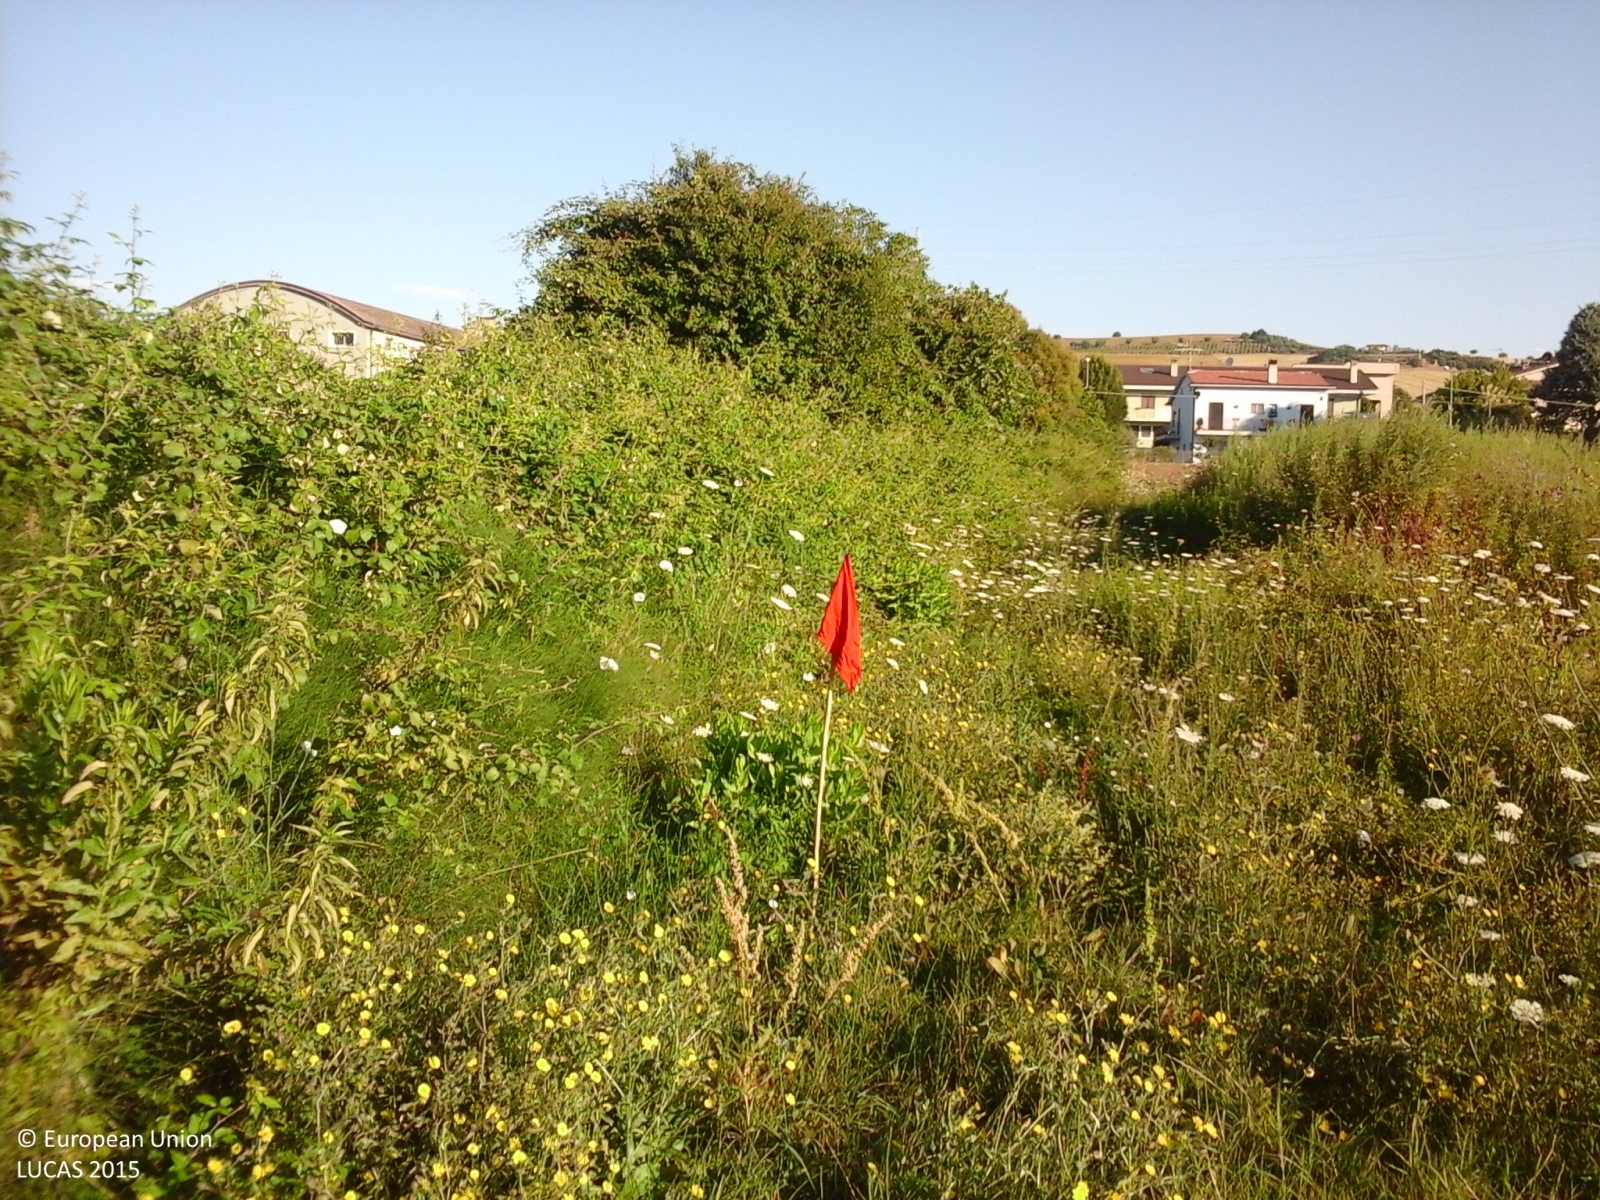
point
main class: Grassland
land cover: Spontaneously vegetated surfaces
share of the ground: > 75 %
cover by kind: herbaceous plants 100 %
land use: Fallow land
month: July
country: IT
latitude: 43.1615
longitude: 13.7906
